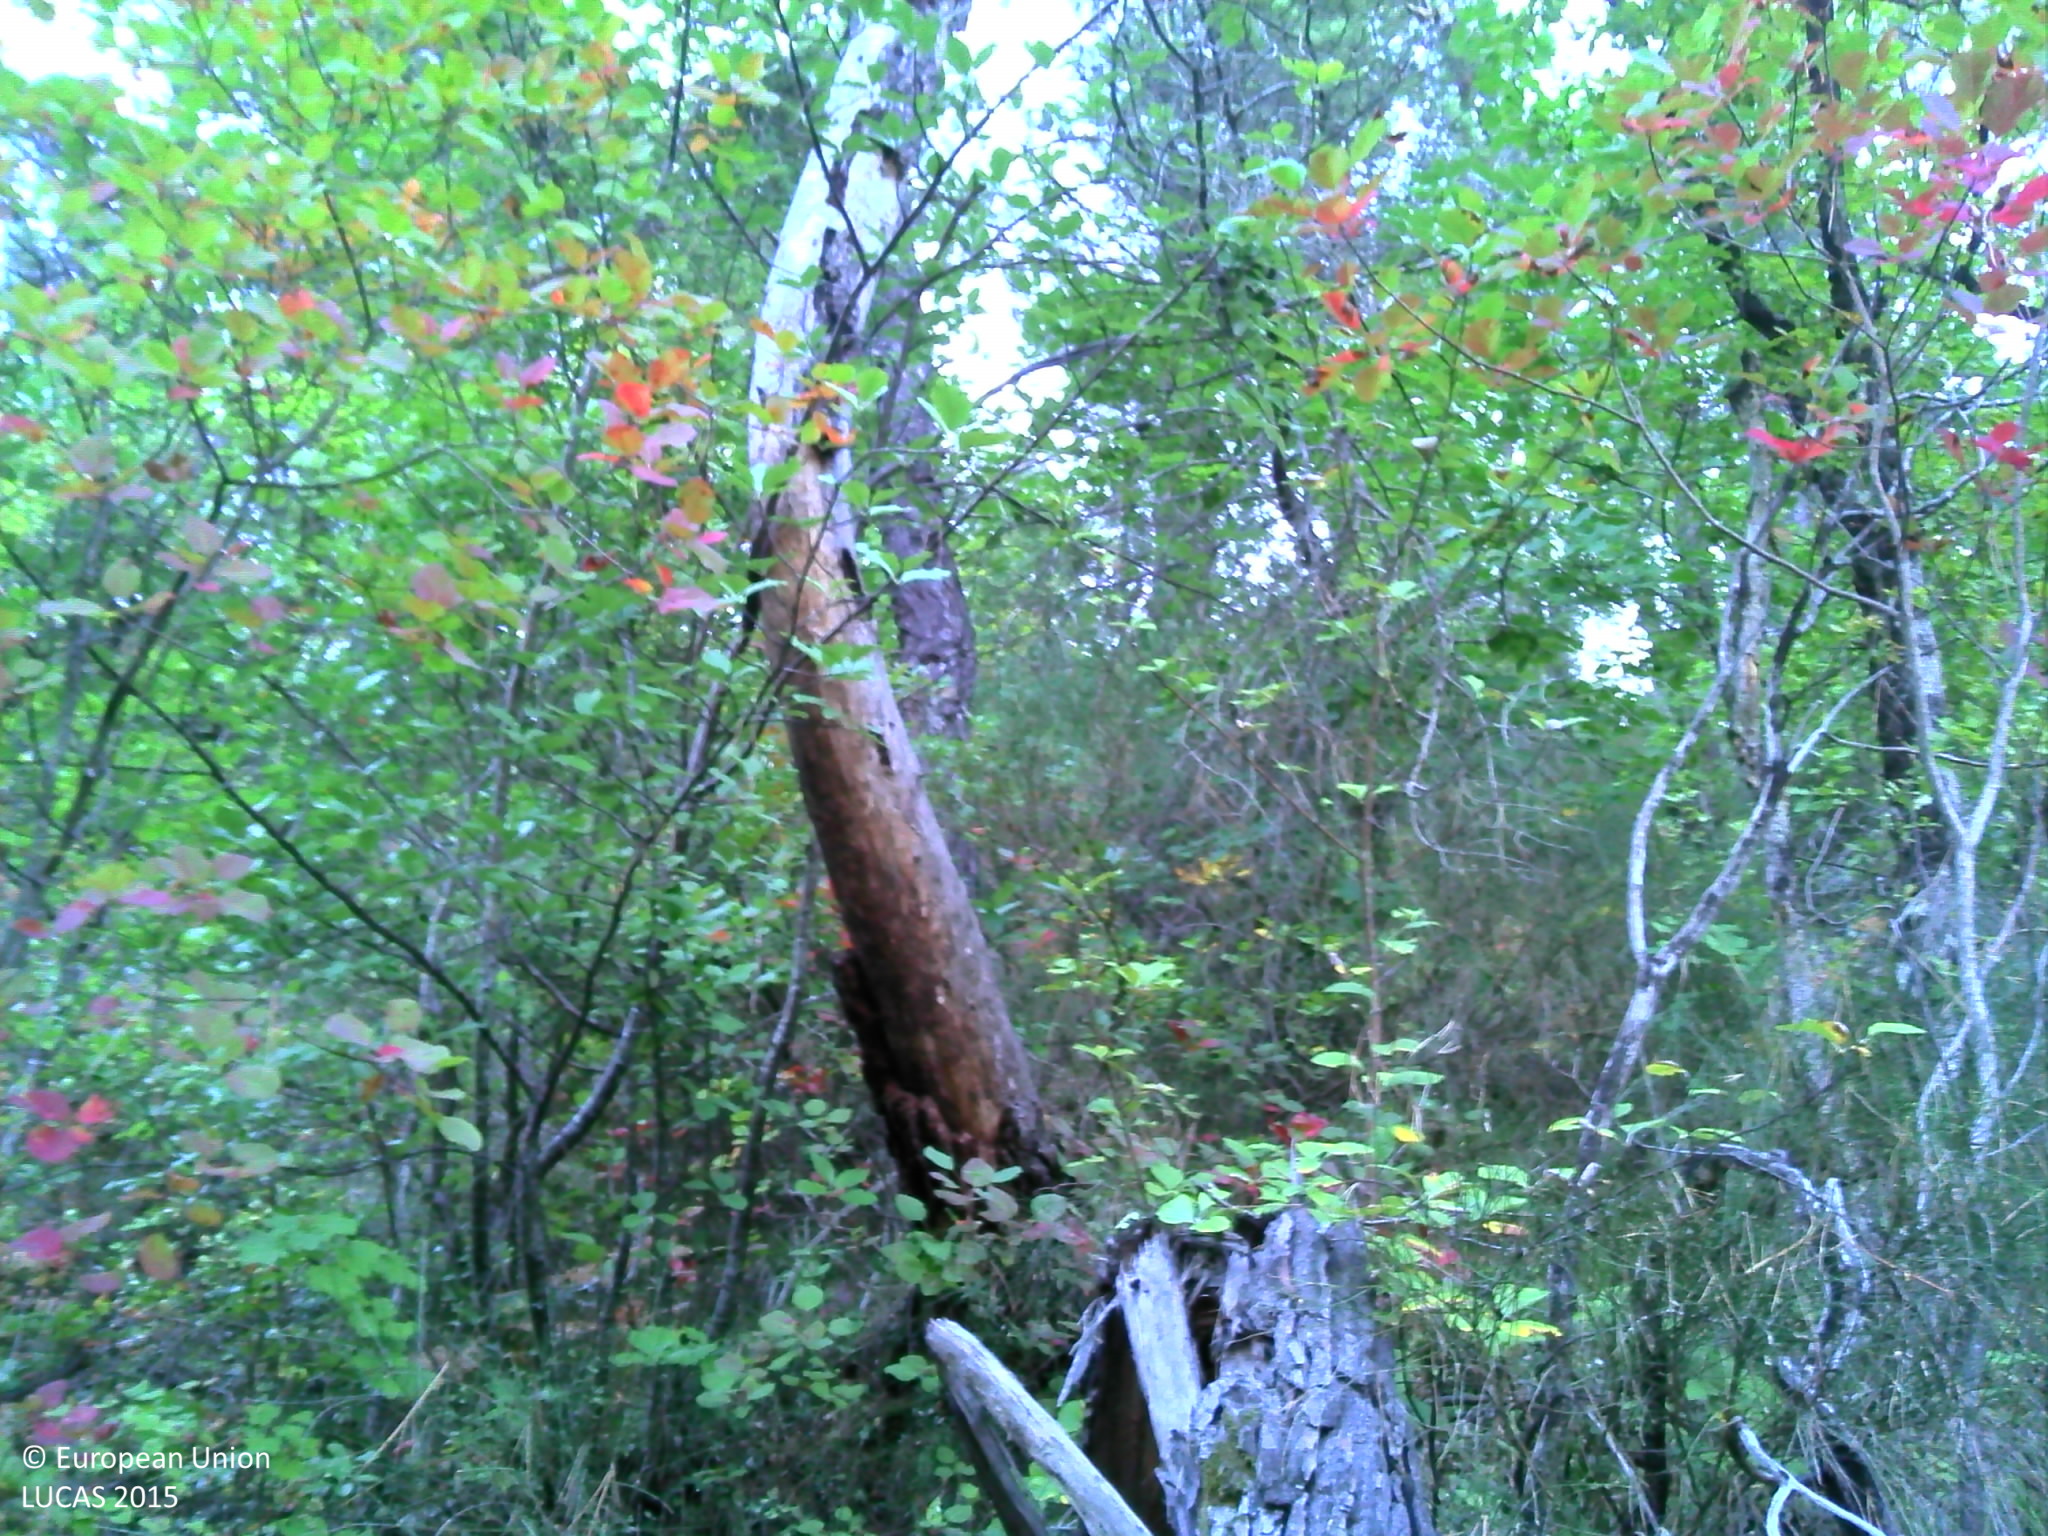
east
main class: Woodland
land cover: Pine dominated mixed woodland
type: coniferous forest of the mediterranean region
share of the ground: 50 - 75 %
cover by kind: coniferous forest trees 40 %, herbaceous plants 30 %, broadleaved forest trees 20 %, shrubs 5 %, lichens and mosses 5 %
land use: Forestry
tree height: > 5 m
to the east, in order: Pine dominated mixed woodland; Tracks; Pine dominated mixed woodland; Pine dominated coniferous woodland; Pine dominated mixed woodland; Electric lines; Tracks; Pine dominated coniferous woodland; Grassland with sparse tree/shrub cover; Olive groves; Dry stone walls; Pine dominated mixed woodland; Dry stone walls; Olive groves; Dry stone walls; Olive groves; Pine dominated mixed woodland
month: September
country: FR
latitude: 43.8770
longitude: 7.1070
